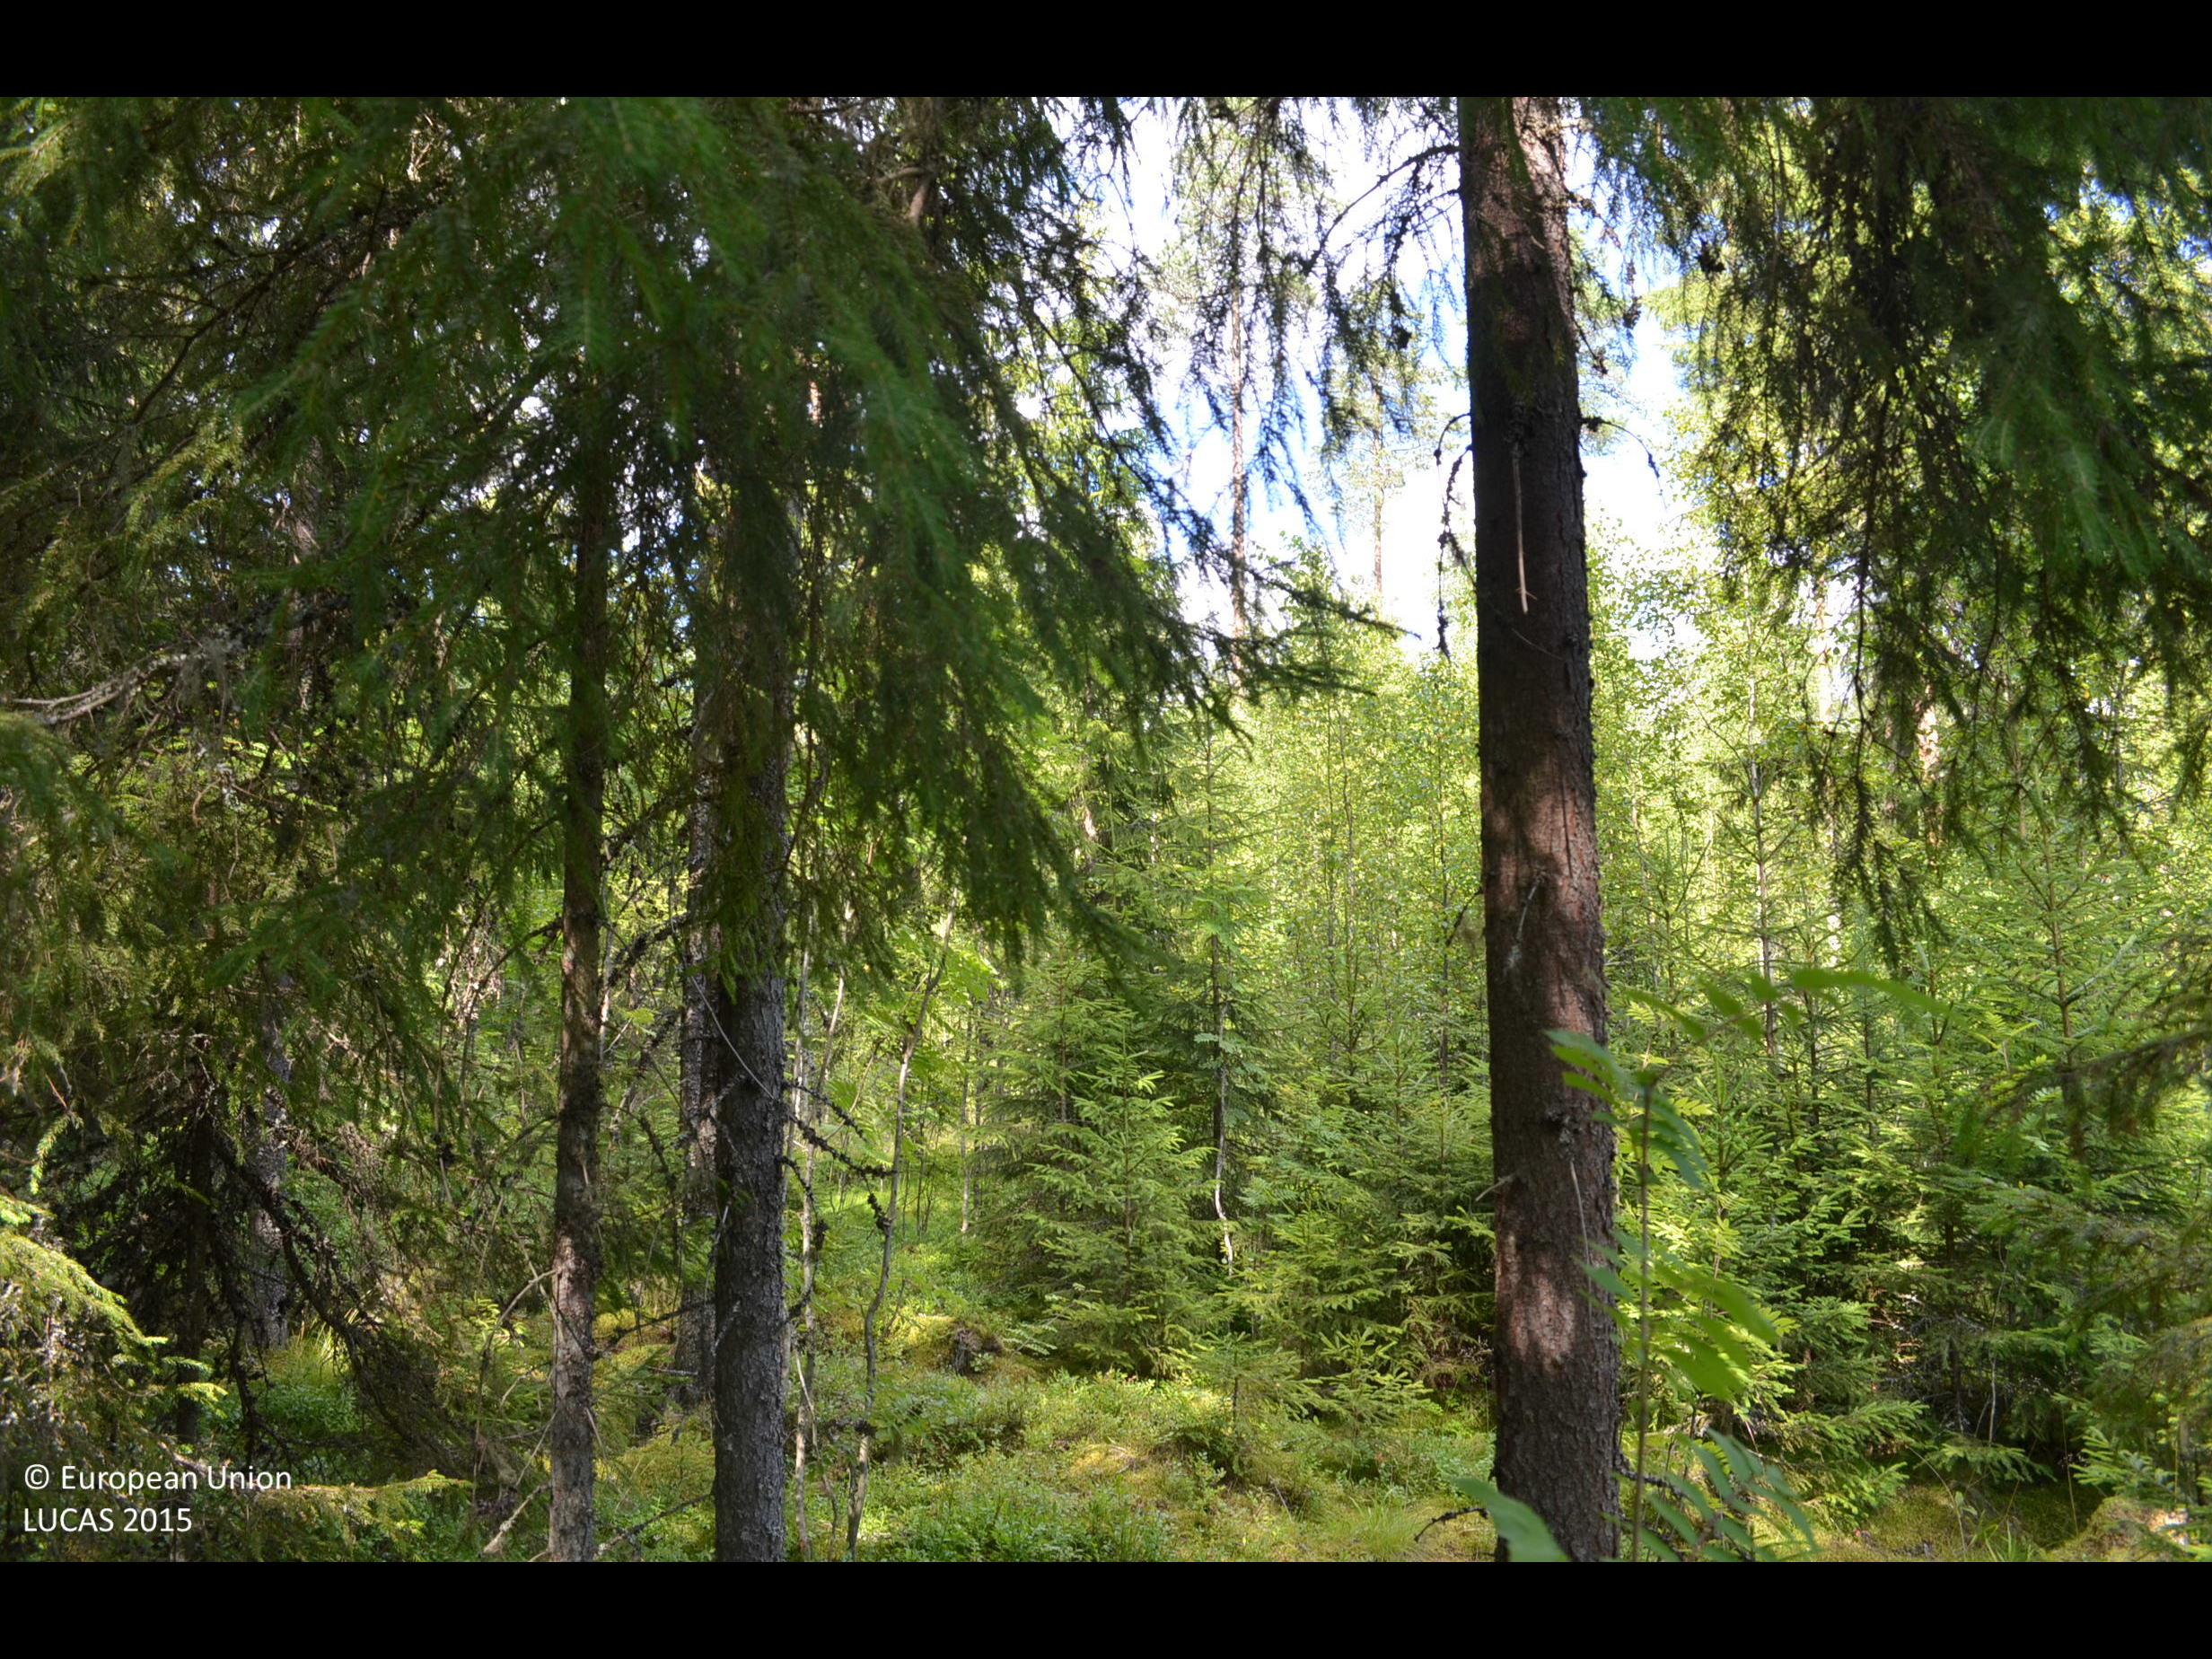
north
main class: Woodland
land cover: Spruce dominated coniferous woodland
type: boreal forest
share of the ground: > 75 %
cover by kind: coniferous forest trees 75 %, broadleaved forest trees 10 %, shrubs 10 %, lichens and mosses 5 %
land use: Forestry
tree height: > 5 m
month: August
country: FI
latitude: 61.6398
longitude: 23.0352
